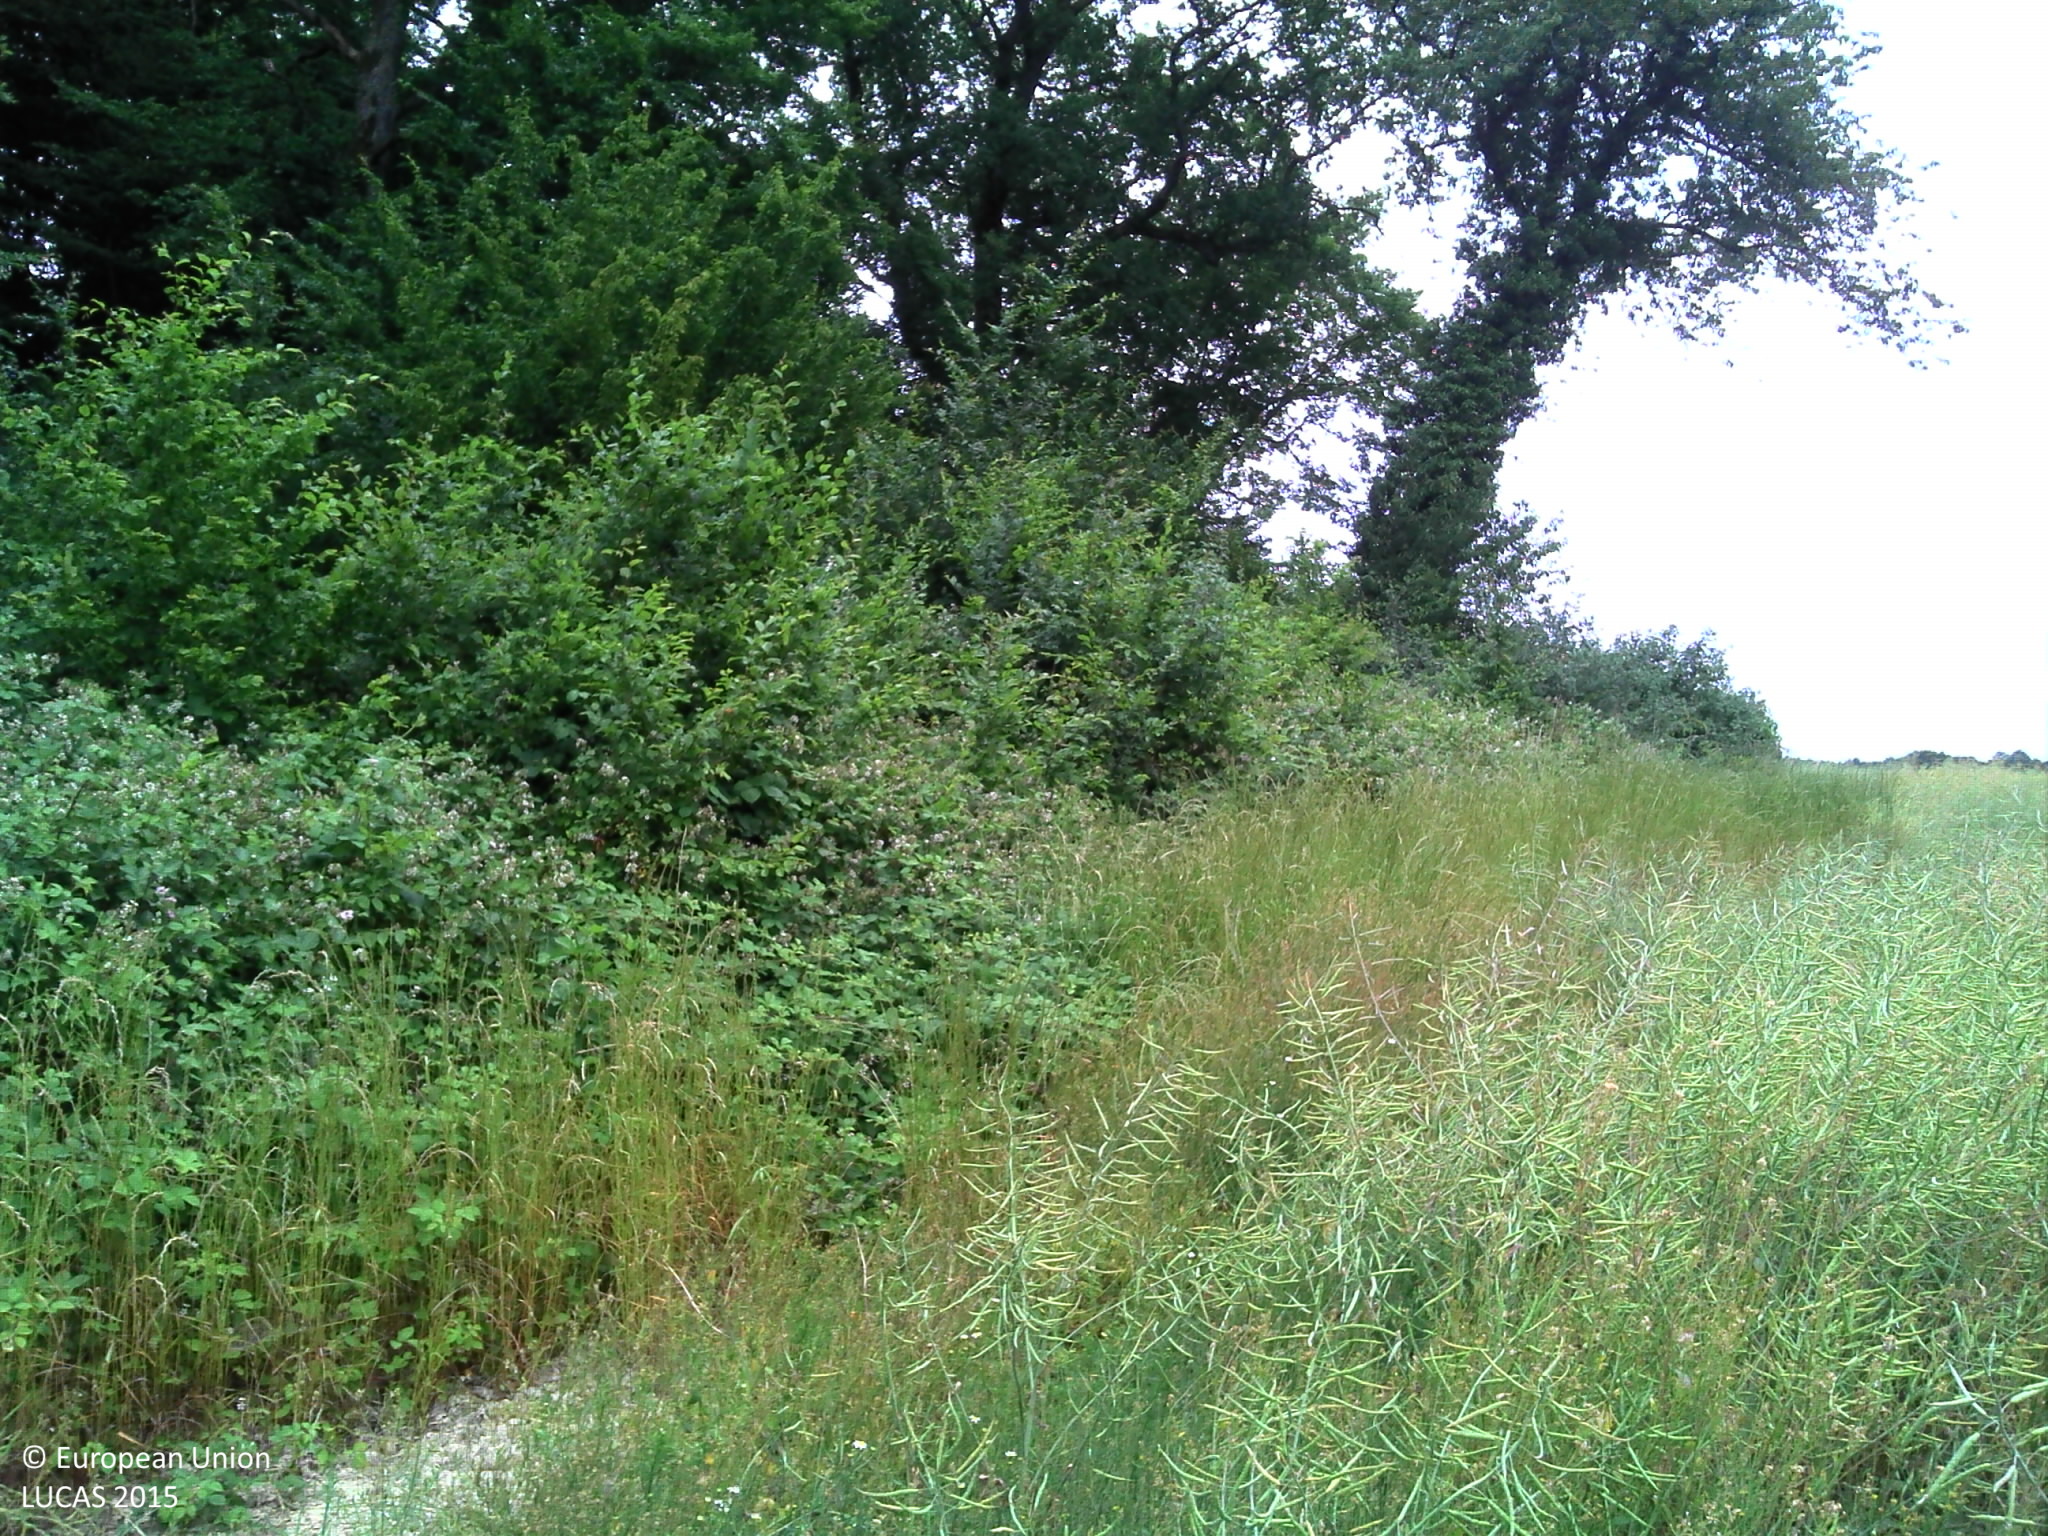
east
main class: Cropland
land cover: Rape and turnip rape
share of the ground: > 75 %
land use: Agriculture (excluding fallow land and kitchen gardens)
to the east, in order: Rape and turnip rape; Spontaneously vegetated surfaces; Broadleaved woodland; Spontaneously vegetated surfaces; Rape and turnip rape
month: June
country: FR
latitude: 46.8047
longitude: 2.6700
